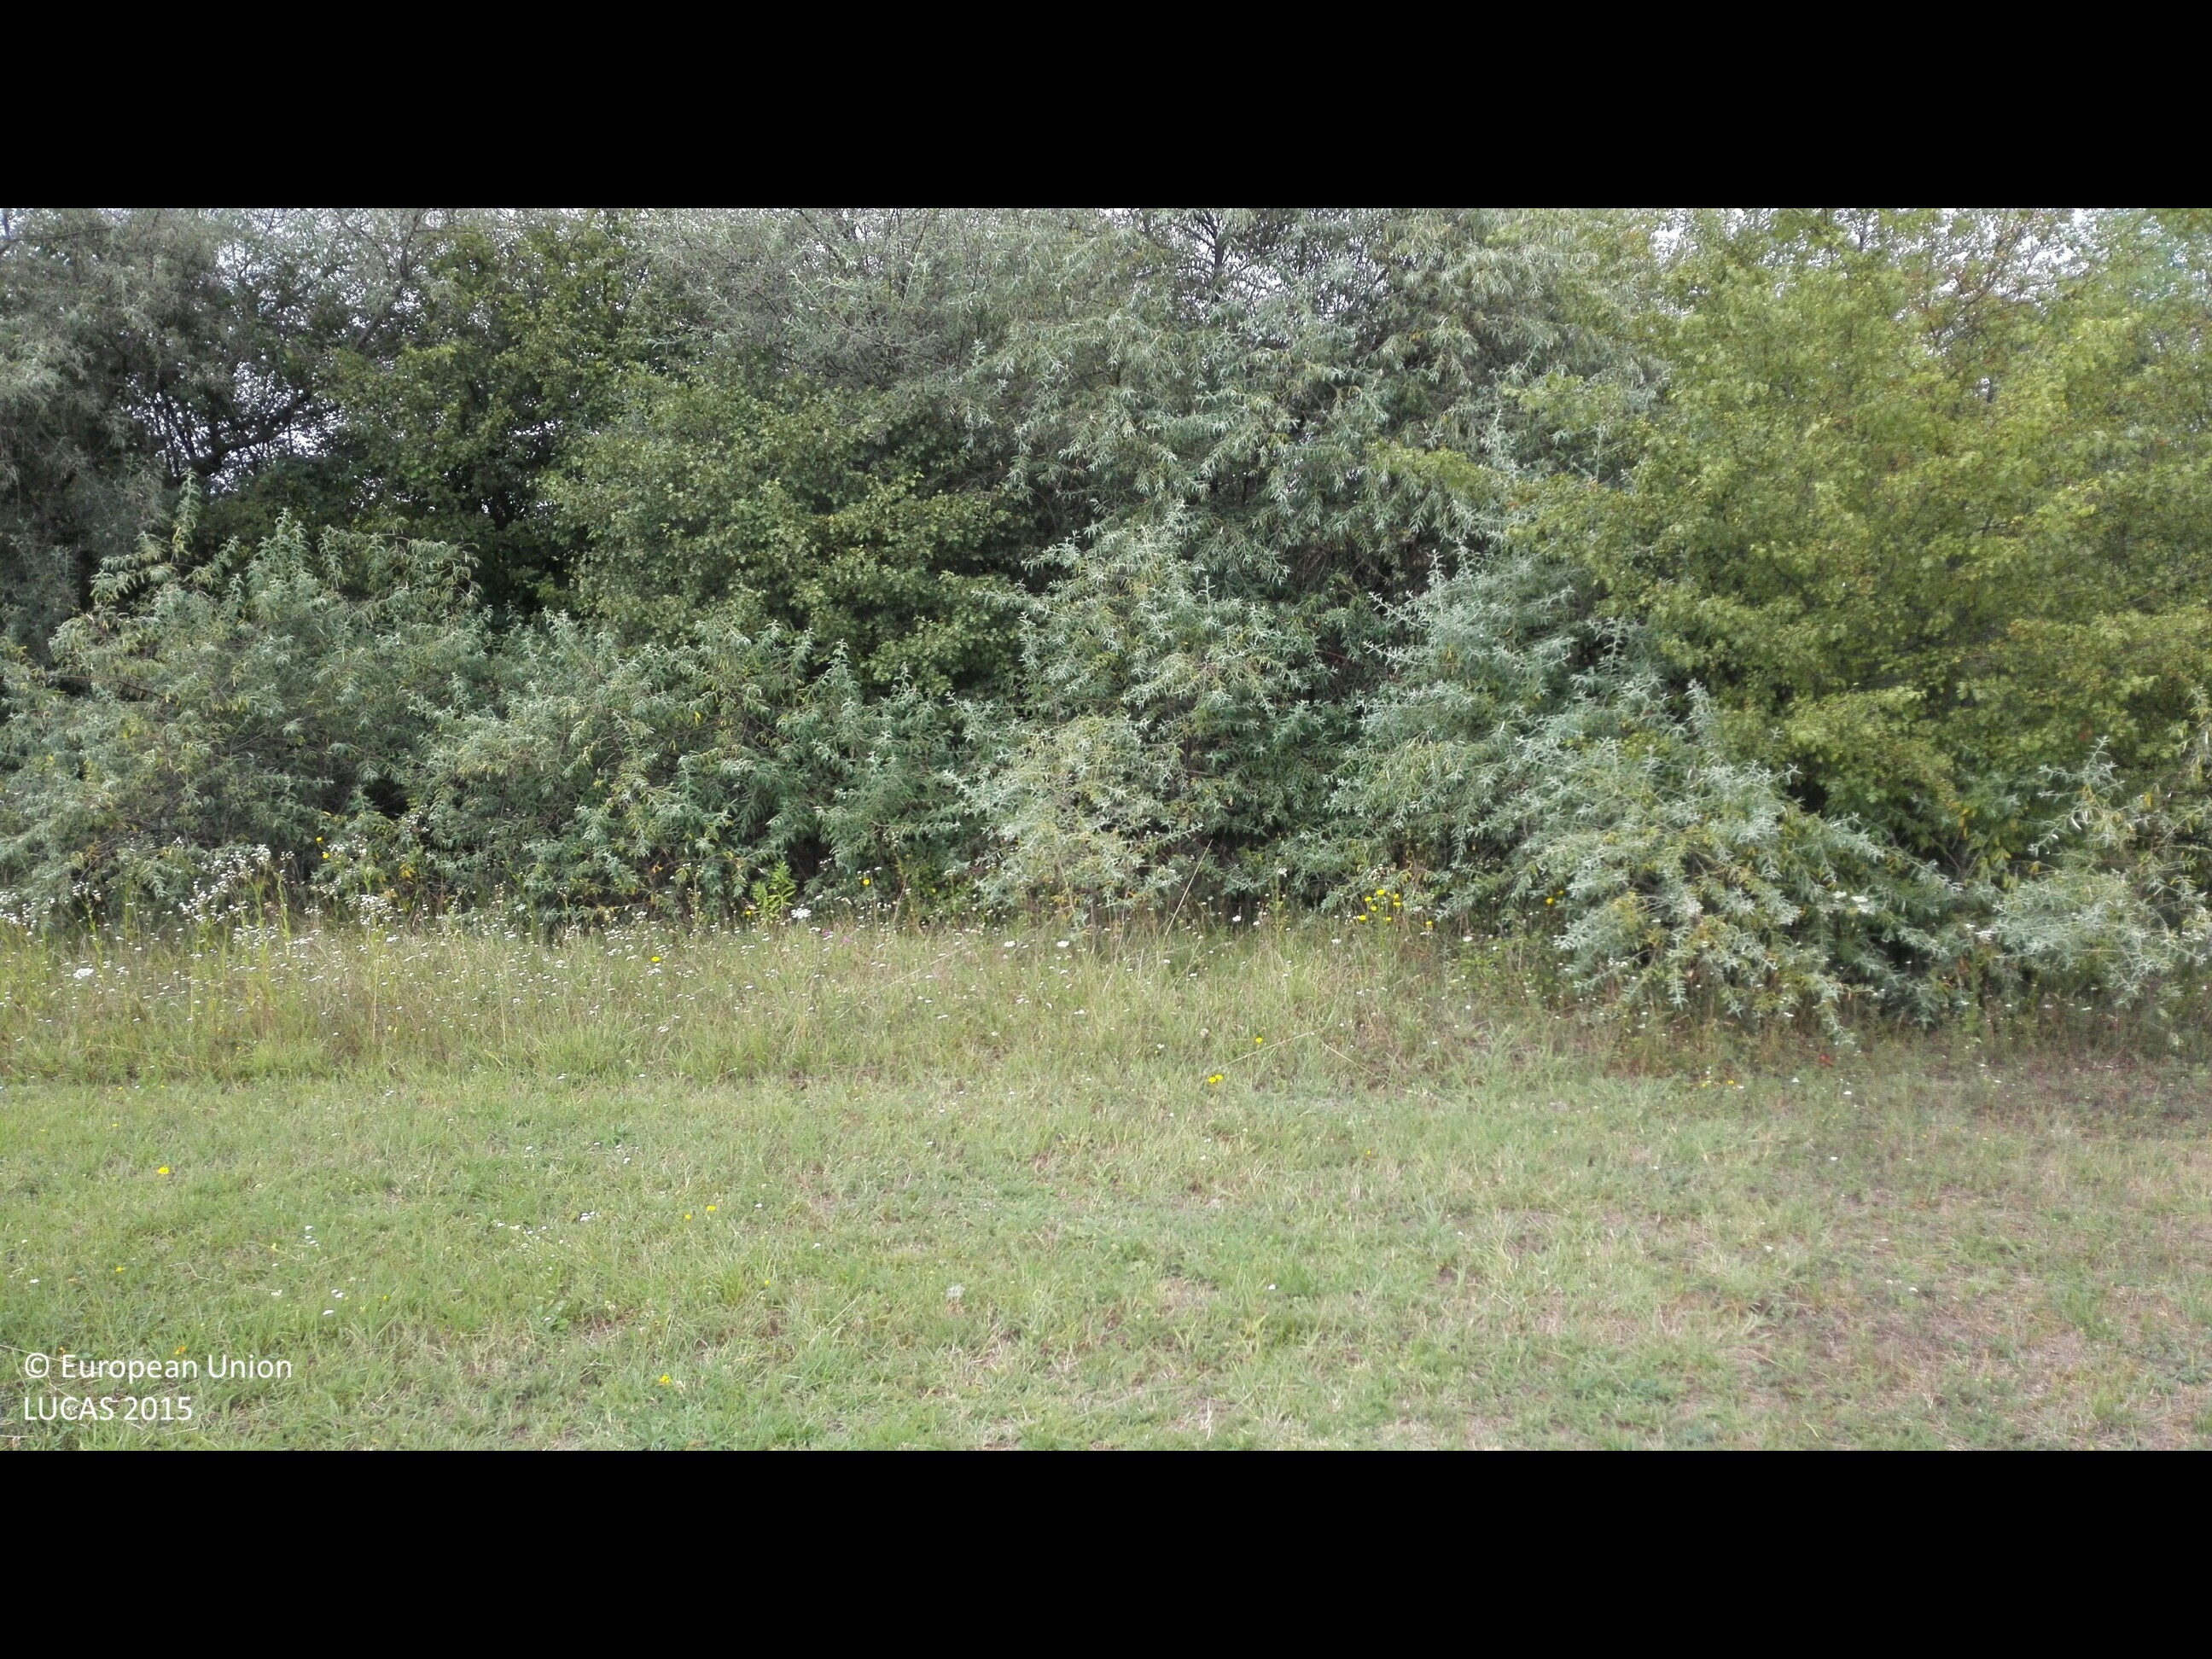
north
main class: Grassland
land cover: Grassland without tree/shrub cover
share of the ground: > 75 %
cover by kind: herbaceous plants 100 %
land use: Agriculture (excluding fallow land and kitchen gardens)
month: August
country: HU
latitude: 47.5410
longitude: 21.7239
